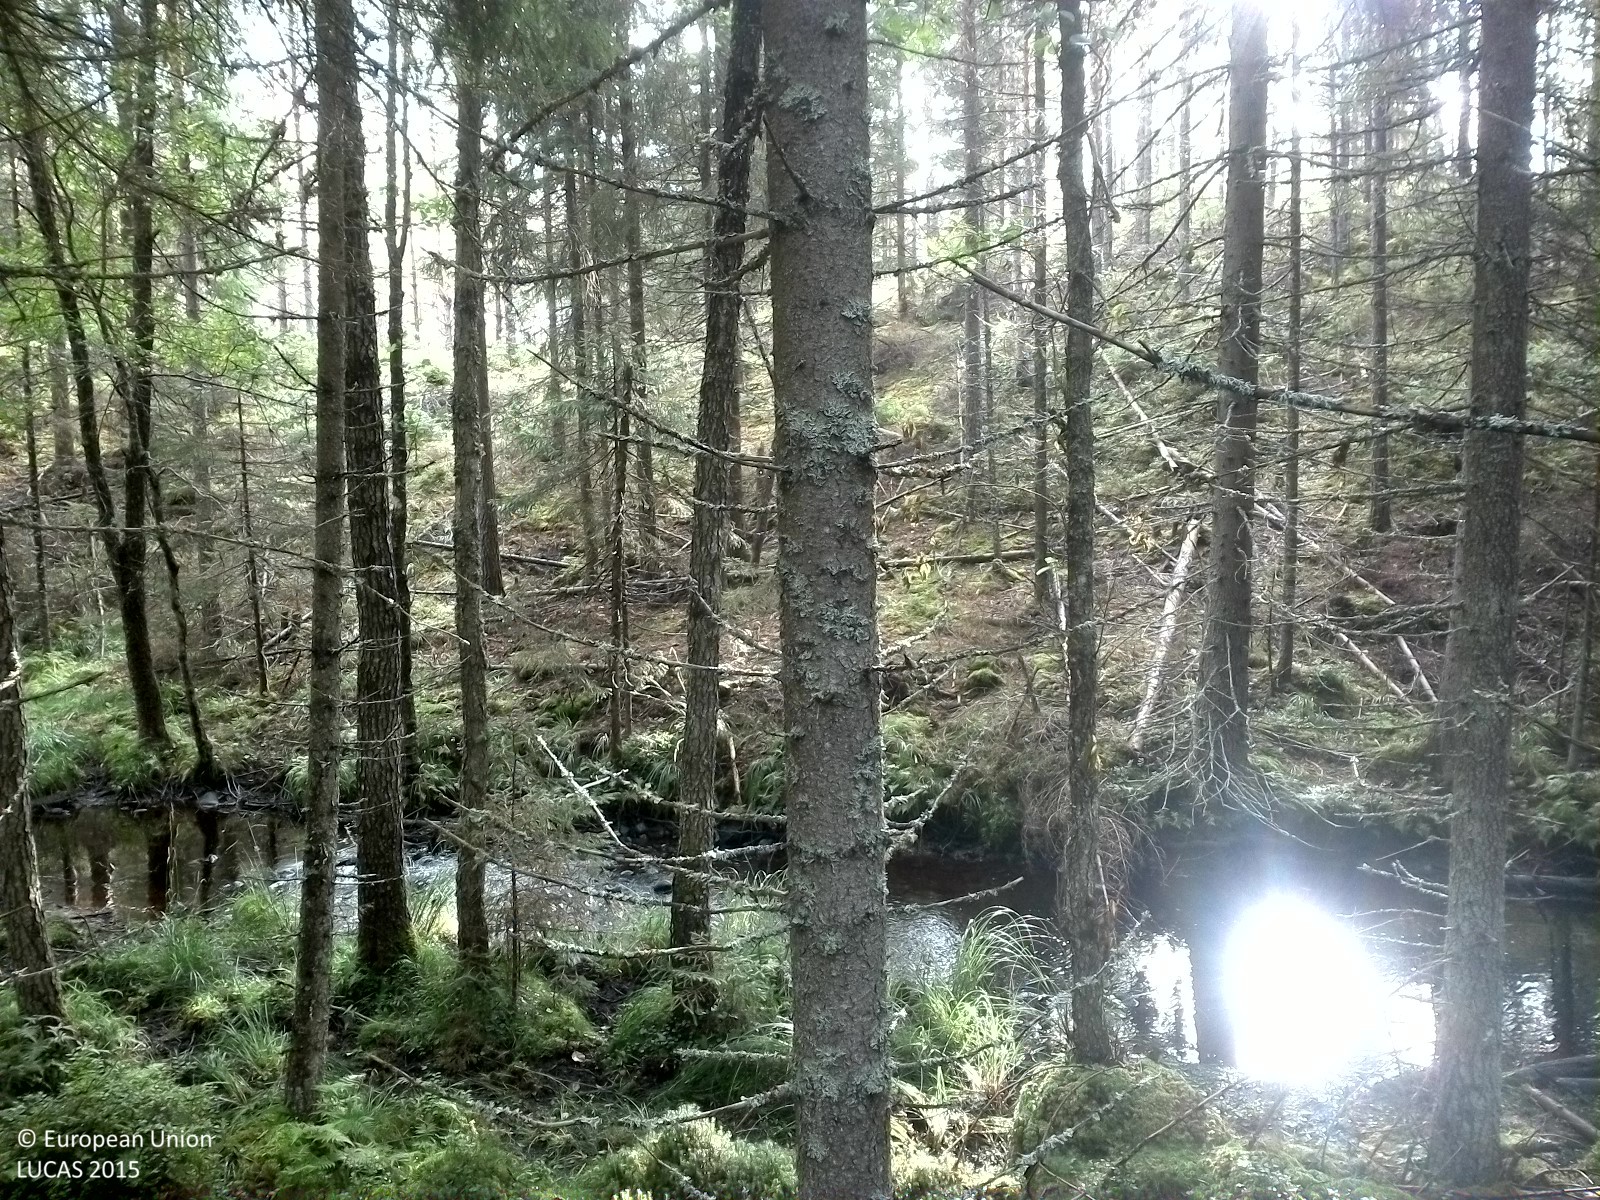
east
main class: Woodland
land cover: Spruce dominated coniferous woodland
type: boreal forest
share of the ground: 50 - 75 %
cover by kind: coniferous forest trees 55 %, lichens and mosses 30 %, unconsolidated bare surface 10 %, herbaceous plants 5 %
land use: Forestry
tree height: > 5 m
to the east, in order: Spruce dominated coniferous woodland; Rivers and streams; Other mixed woodland; Other coniferous woodland; Pine dominated coniferous woodland; Grass margins; Paved roads, cycling and walking lanes; Grass margins; Pine dominated coniferous woodland; Tracks; Other coniferous woodland
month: August
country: SE
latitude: 58.9546
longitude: 15.5037
